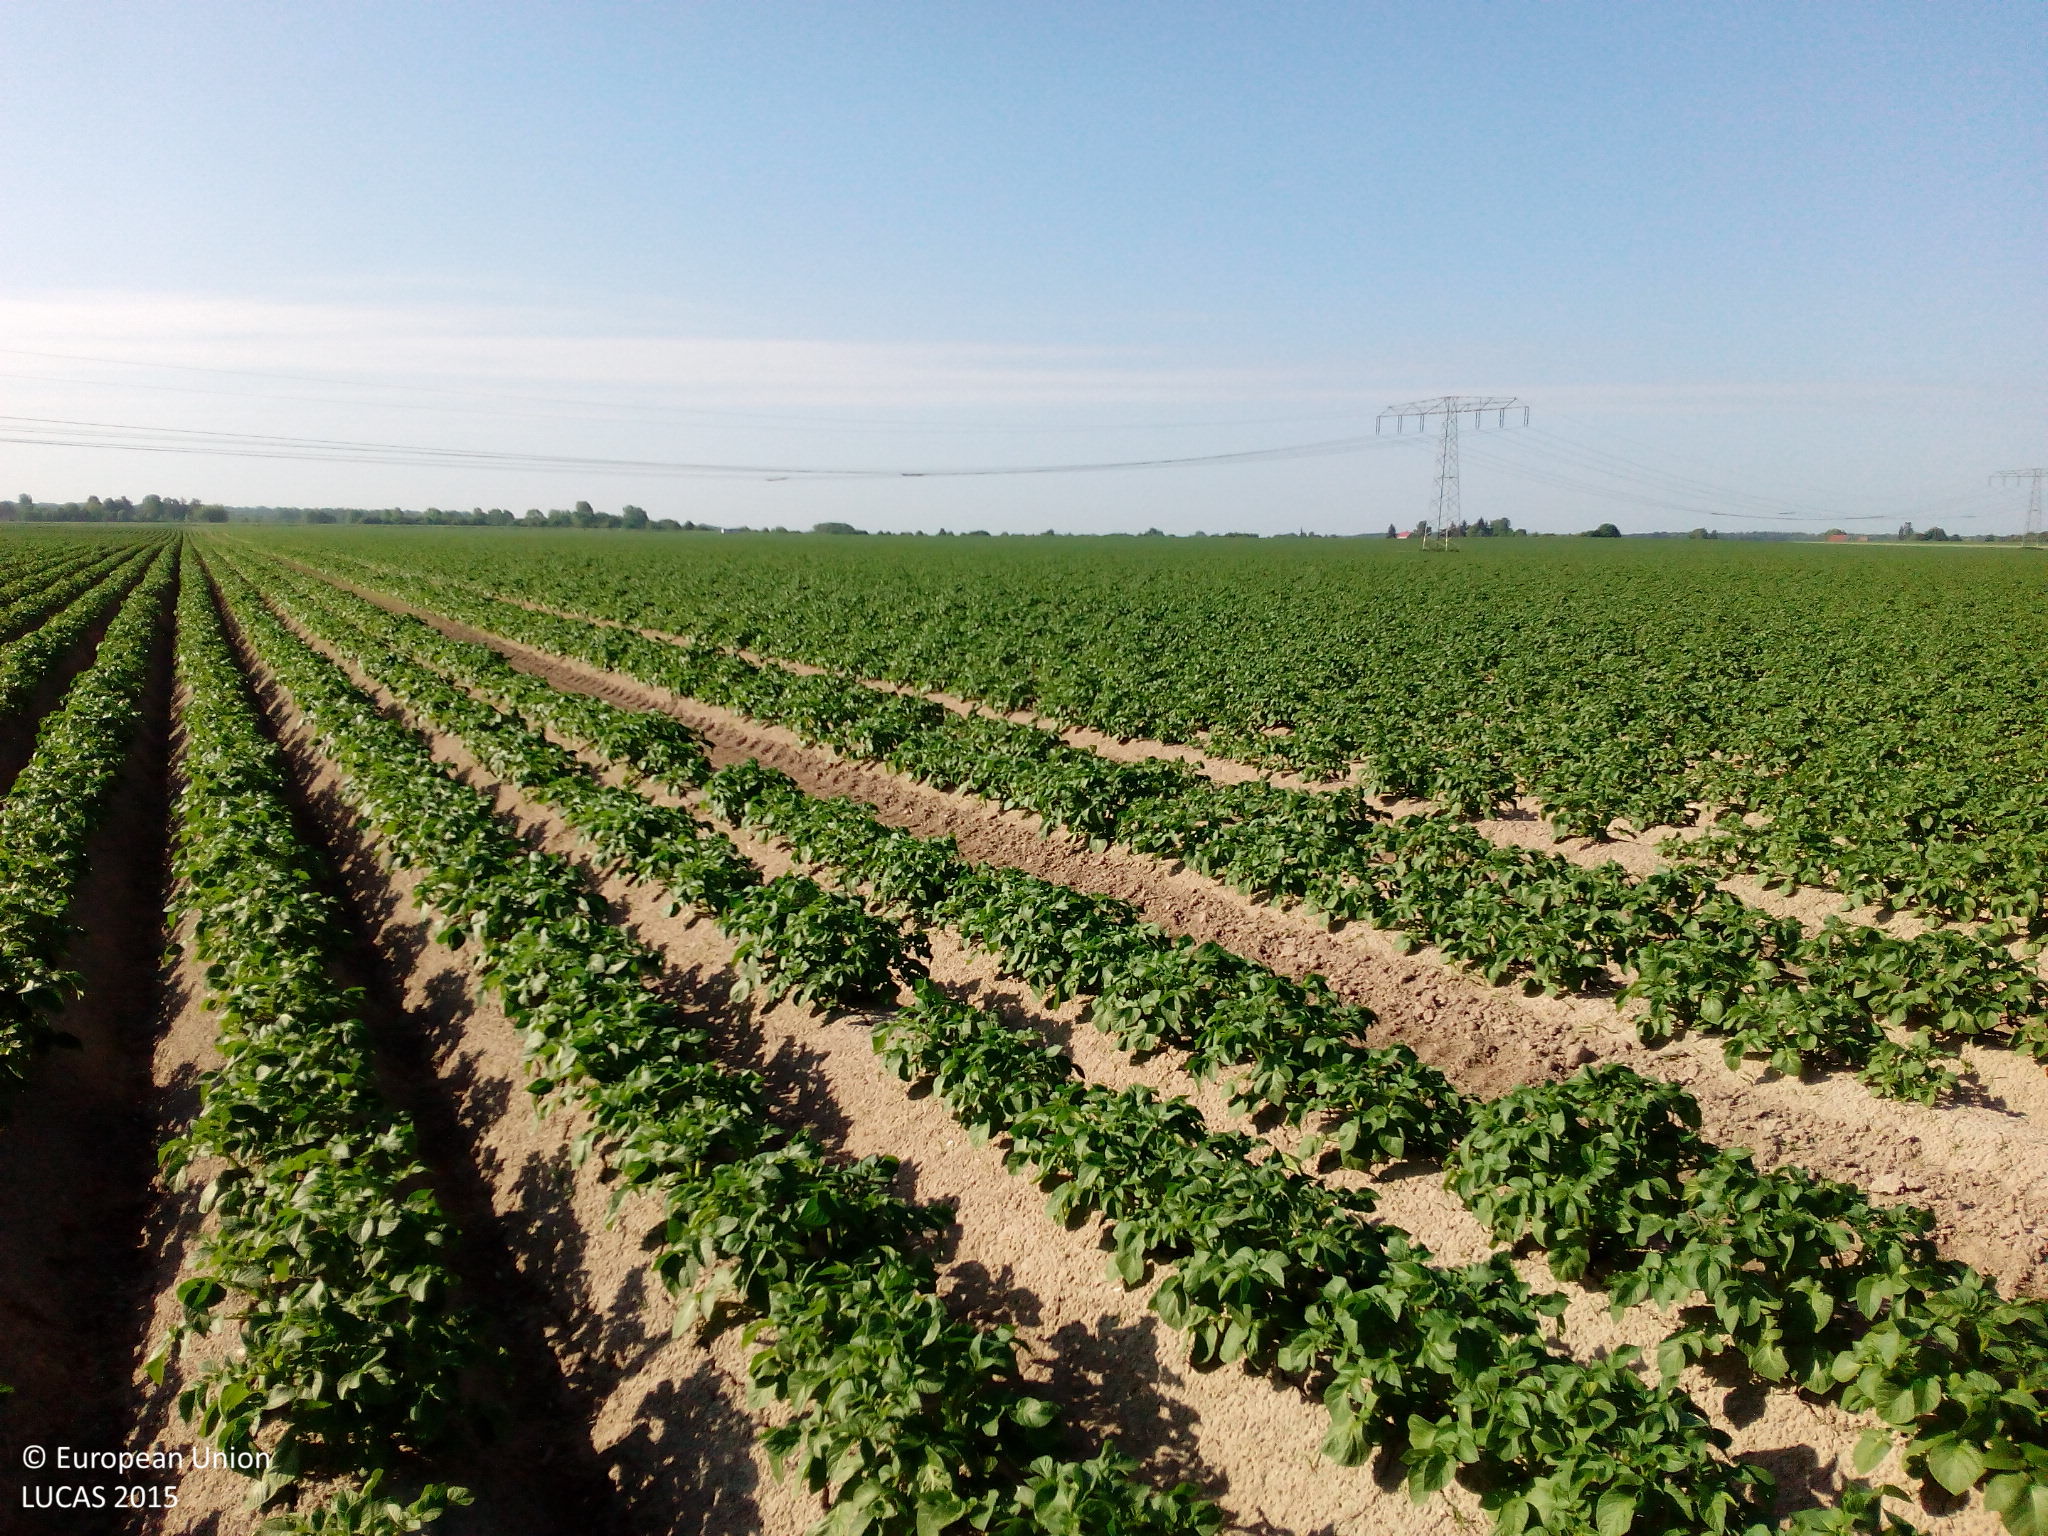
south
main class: Cropland
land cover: Potatoes
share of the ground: 50 - 75 %
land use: Agriculture (excluding fallow land and kitchen gardens)
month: June
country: DE
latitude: 51.0557
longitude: 12.5250
